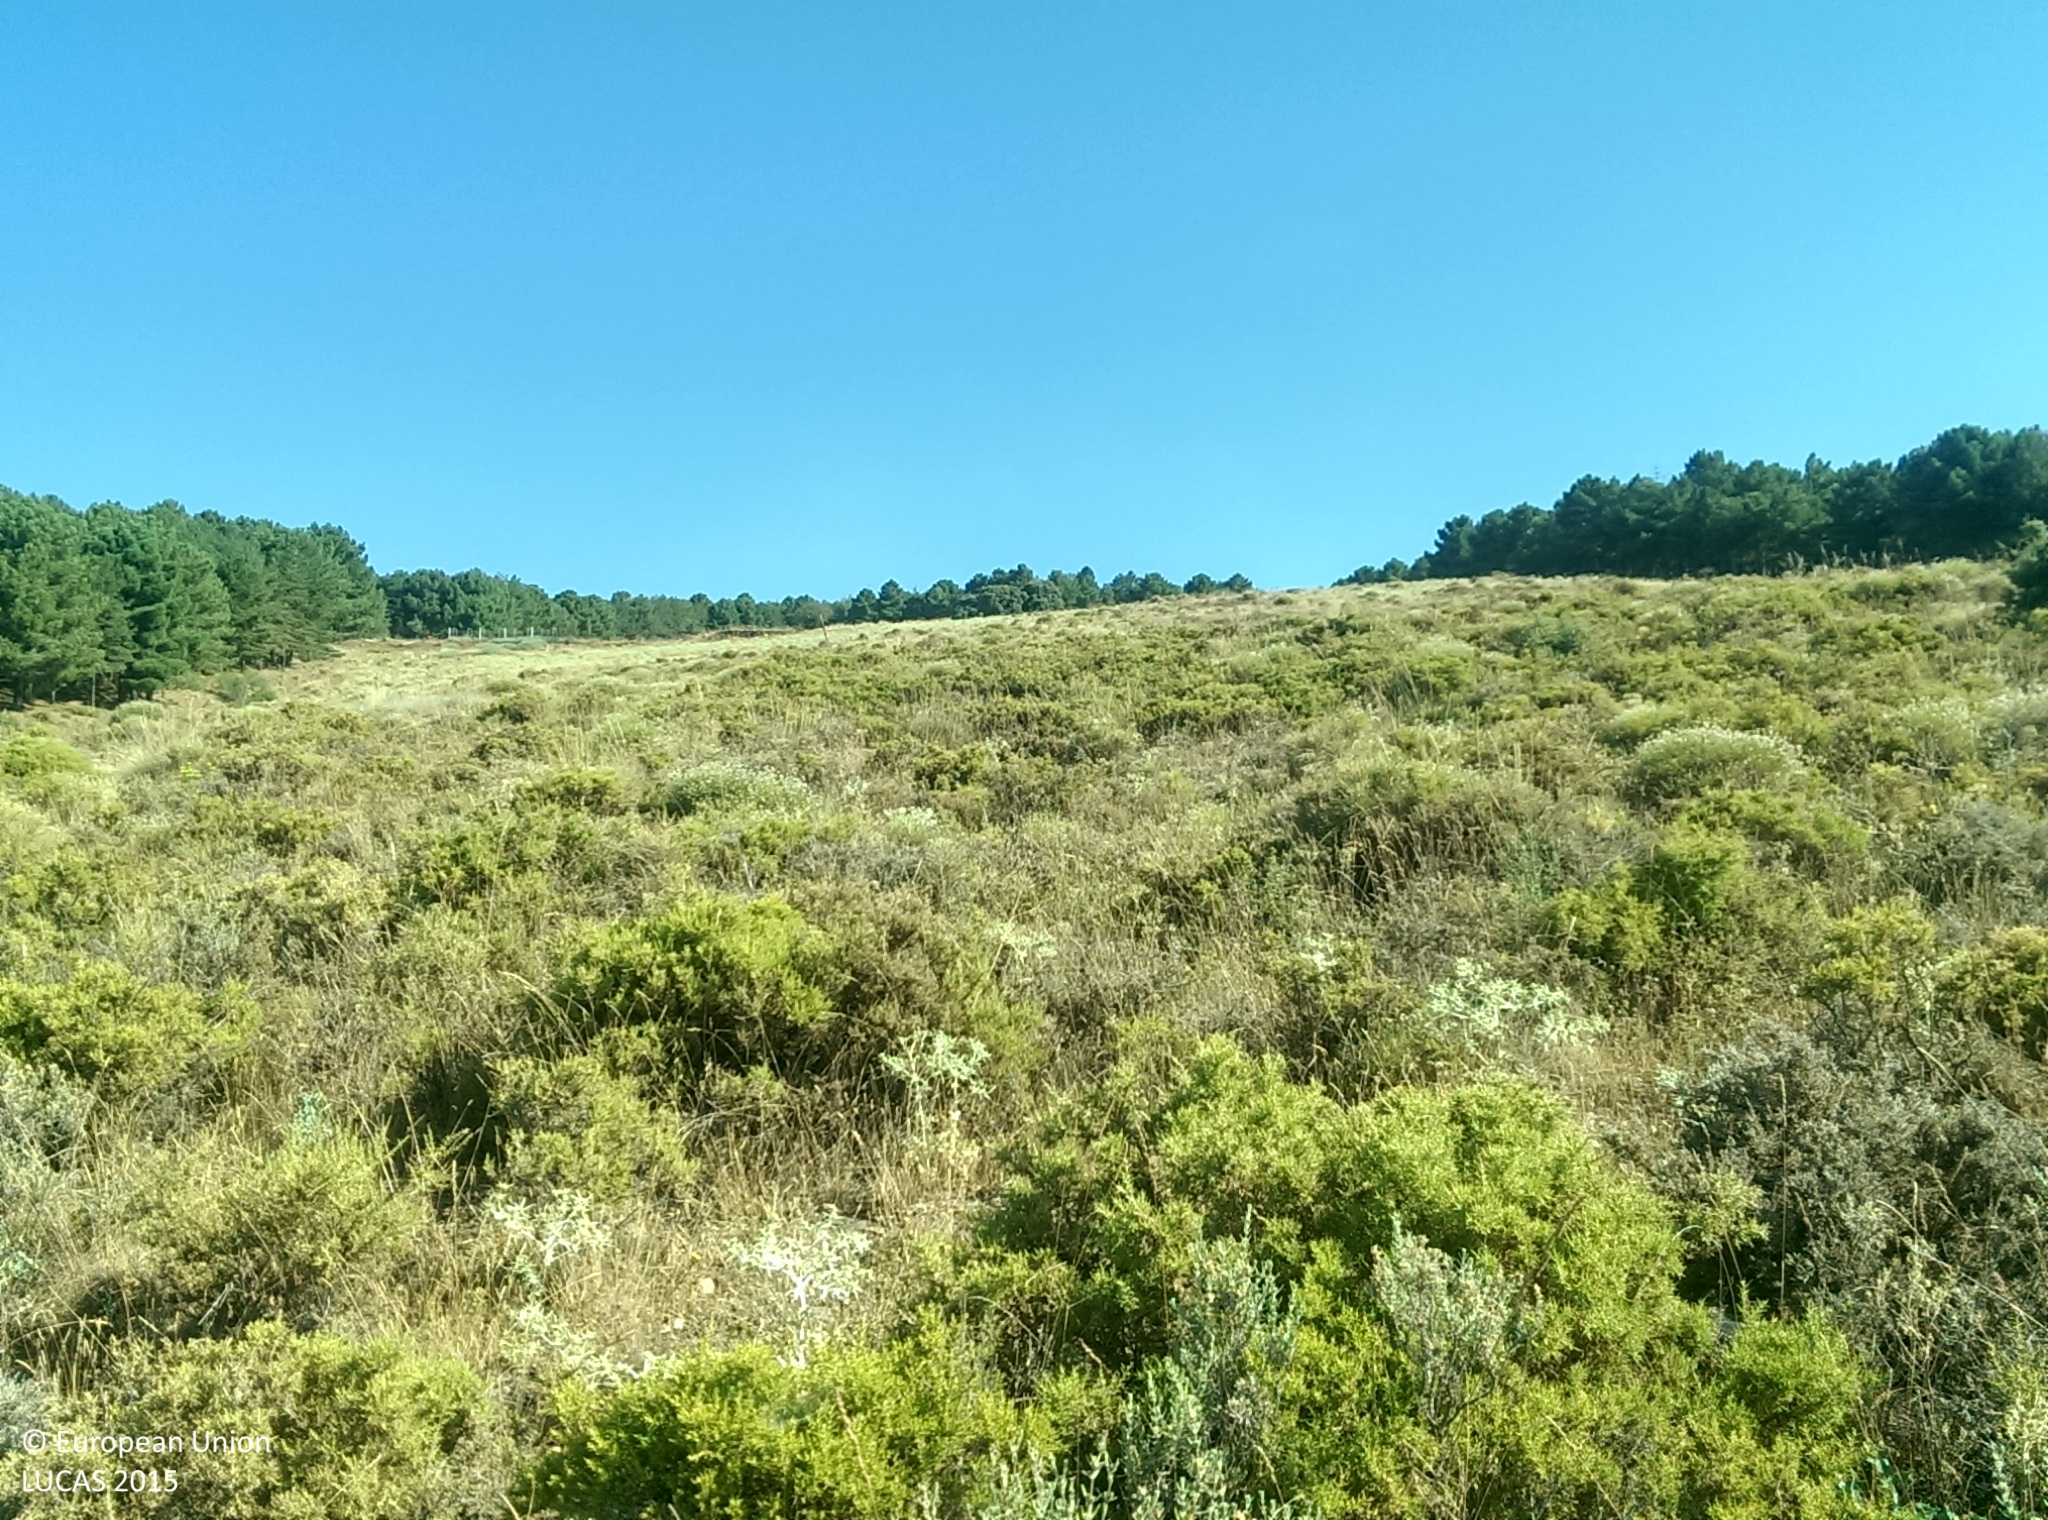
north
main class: Shrubland
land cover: Shrubland without tree cover
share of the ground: > 75 %
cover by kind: shrubs 75 %, herbaceous plants 20 %, unconsolidated bare surface 5 %
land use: Semi-natural and natural areas not in use
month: July
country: ES
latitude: 37.0268
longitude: -3.0554
